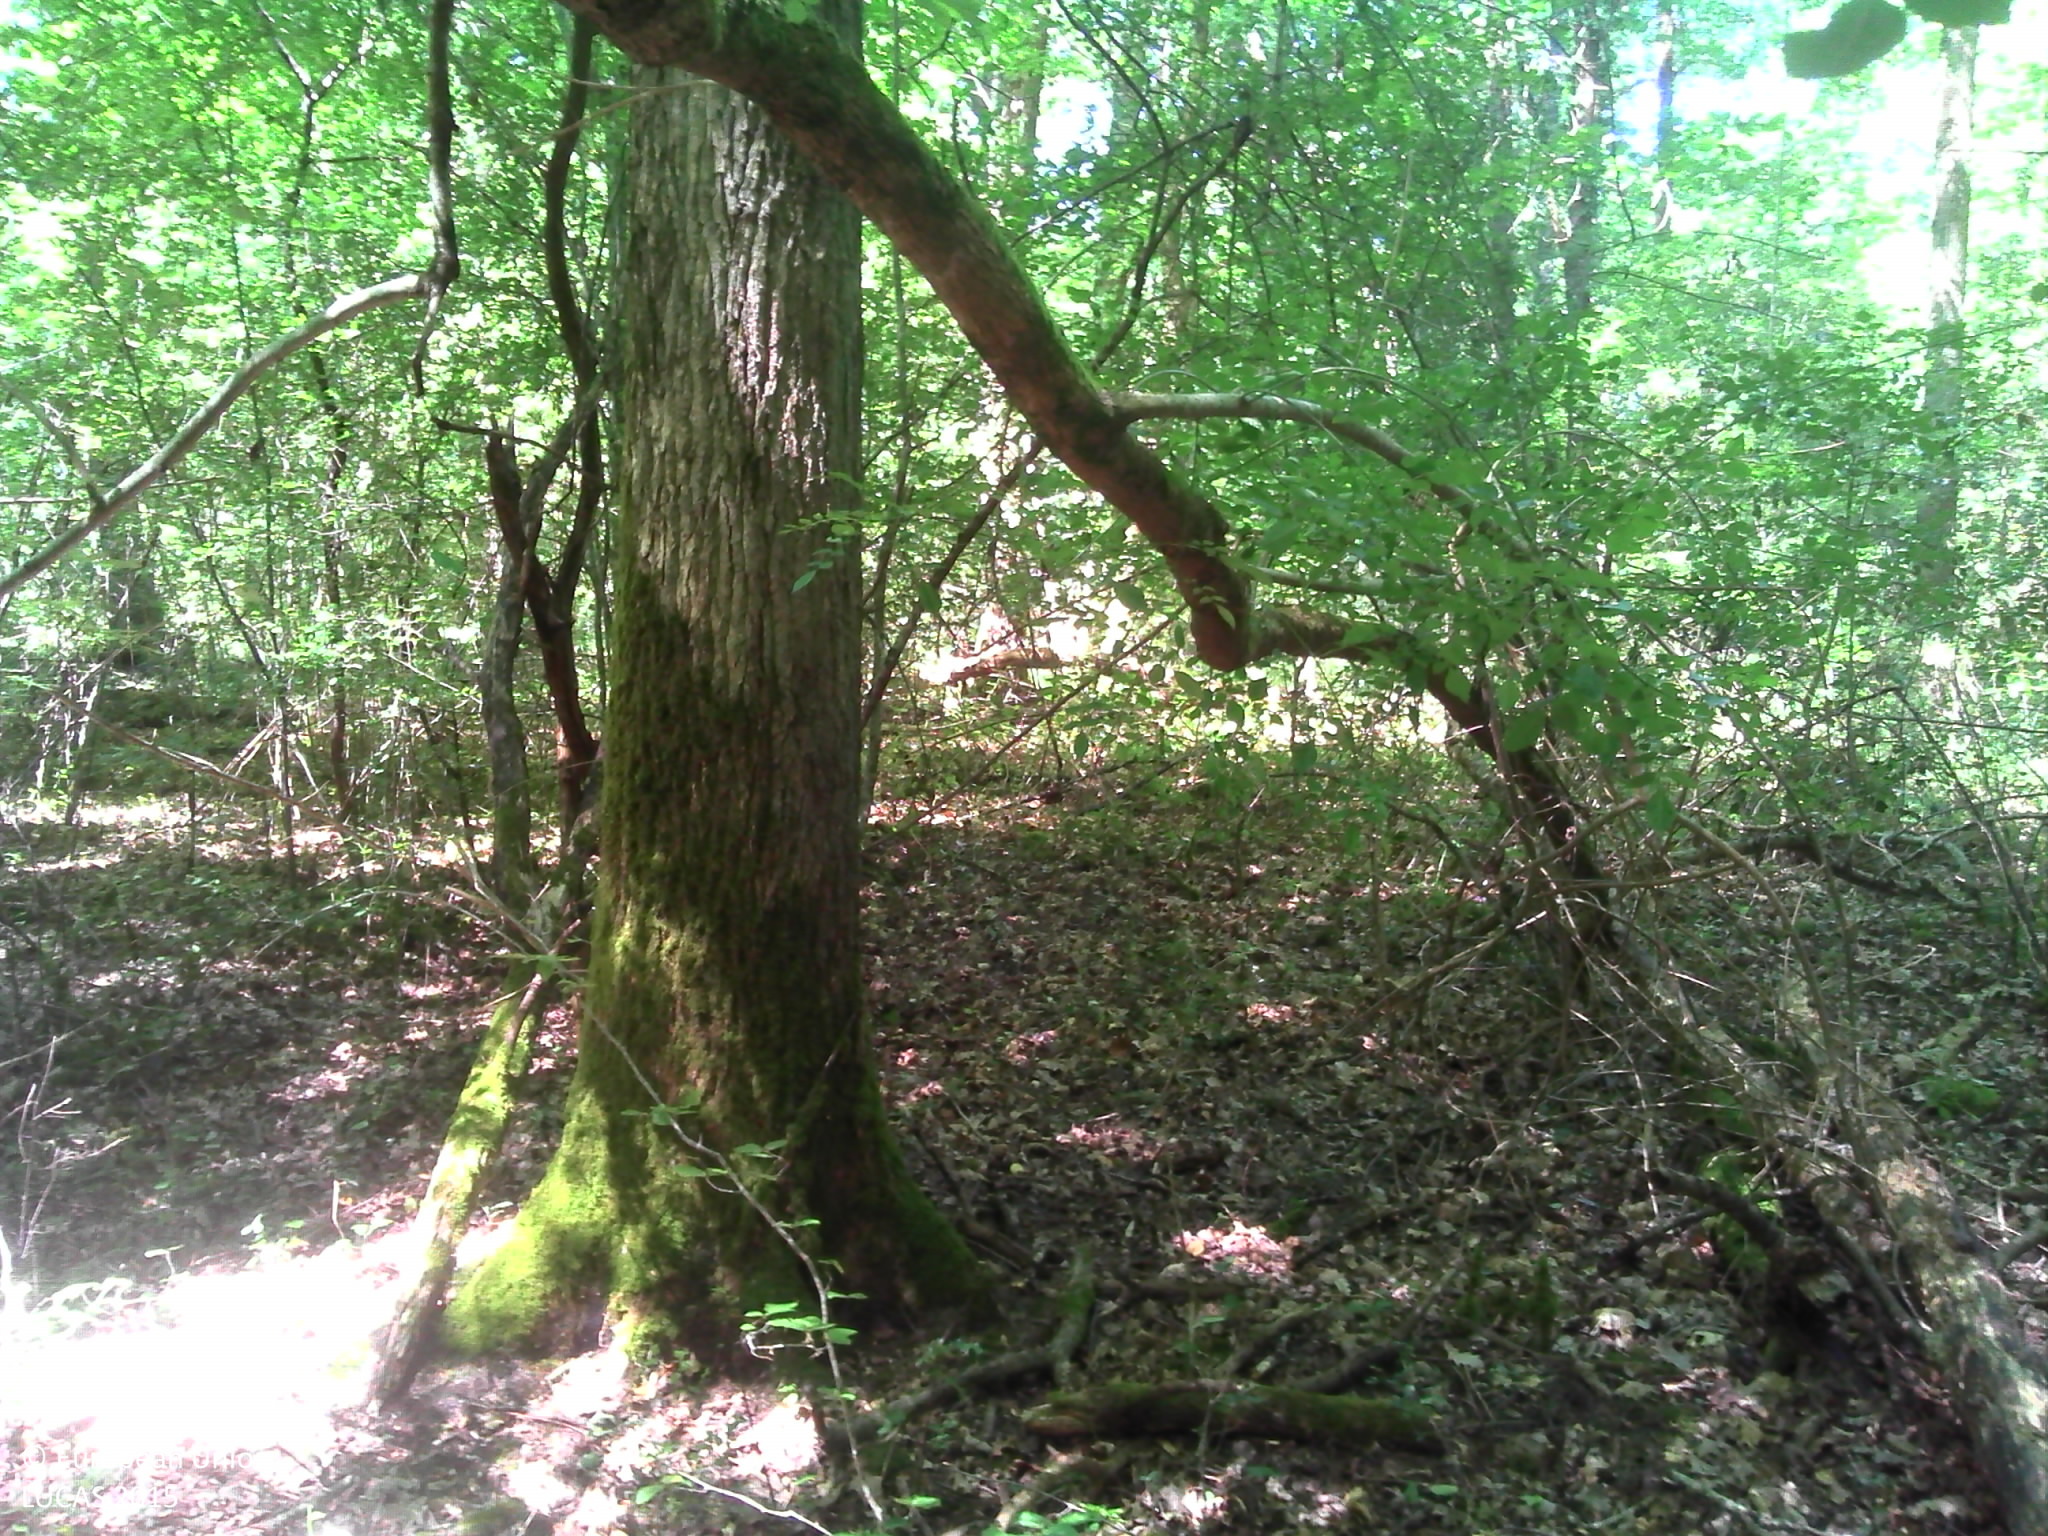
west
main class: Woodland
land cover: Broadleaved woodland
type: mesophytic deciduous forest
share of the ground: > 75 %
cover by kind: broadleaved forest trees 85 %, shrubs 5 %, herbaceous plants 5 %, lichens and mosses 5 %
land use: Forestry
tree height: > 5 m
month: July
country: FR
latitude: 47.2714
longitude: 0.5287
